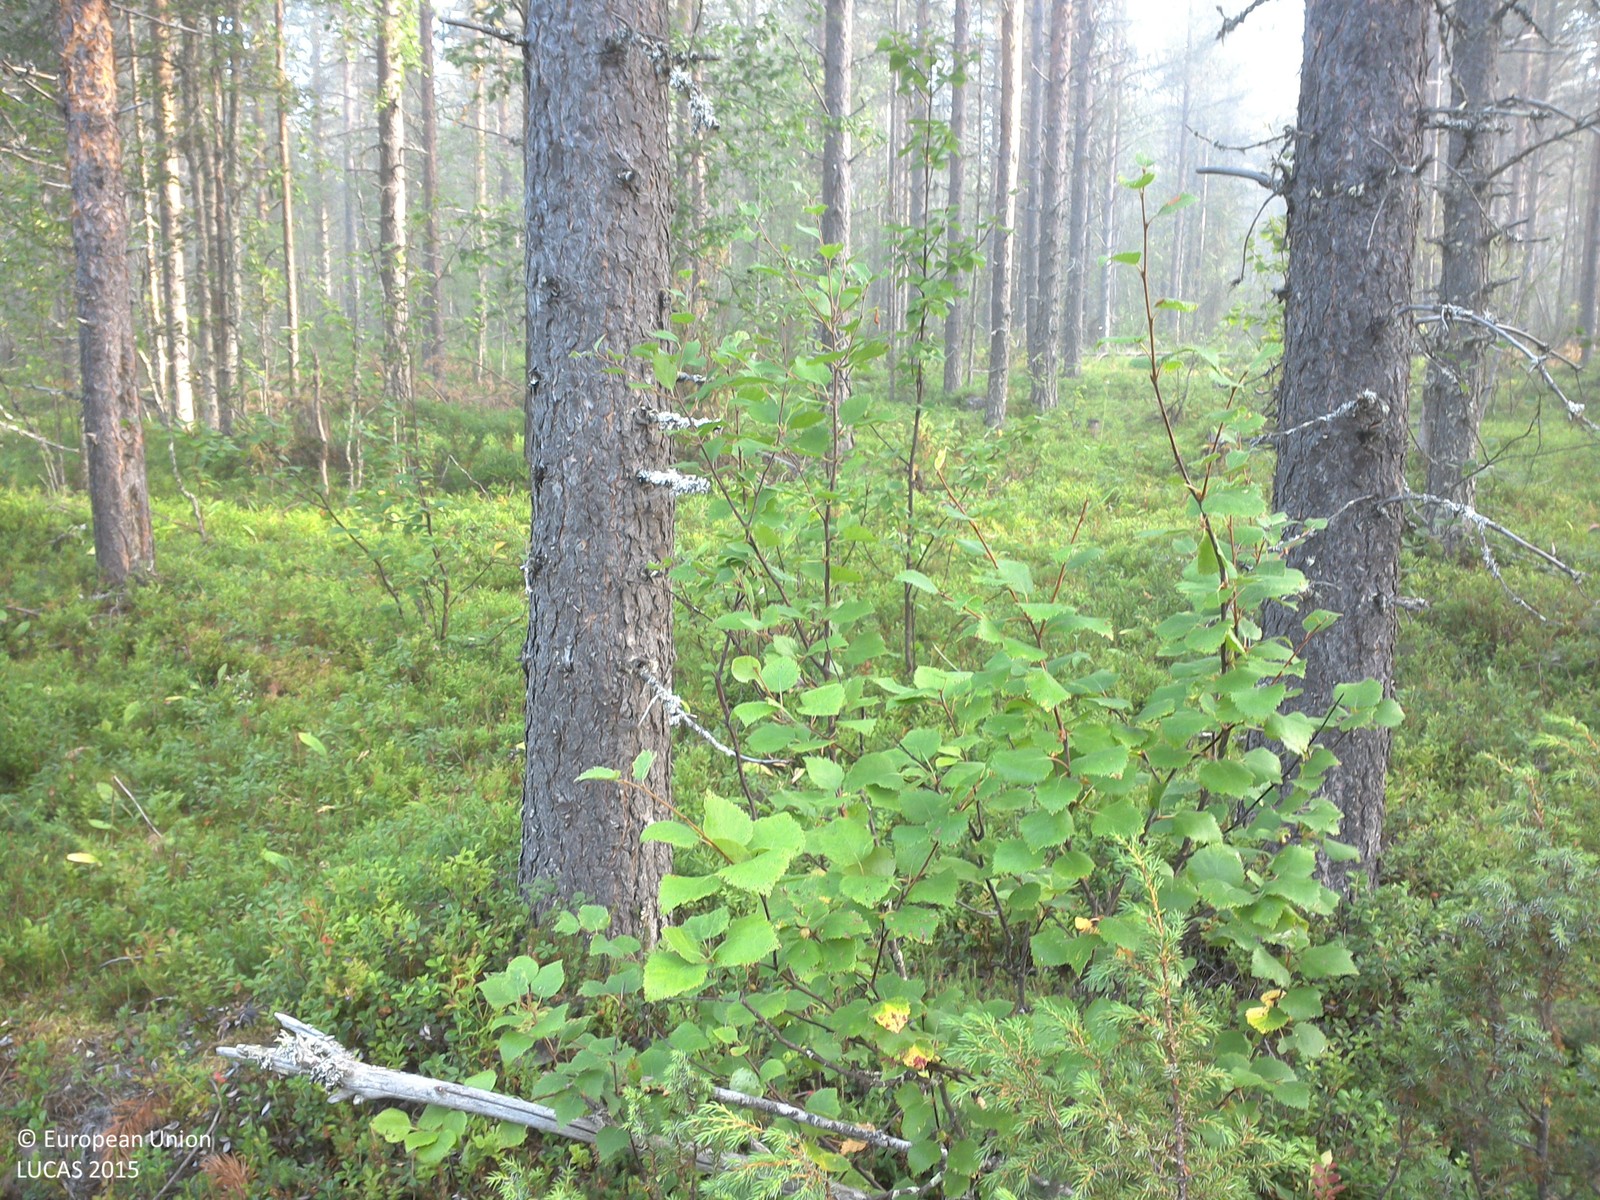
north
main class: Woodland
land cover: Pine dominated coniferous woodland
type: boreal forest
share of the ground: 25 - 50 %
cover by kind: shrubs 60 %, coniferous forest trees 30 %, broadleaved forest trees 5 %, lichens and mosses 5 %
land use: Forestry
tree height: > 5 m
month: August
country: SE
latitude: 67.1224
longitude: 21.8746
